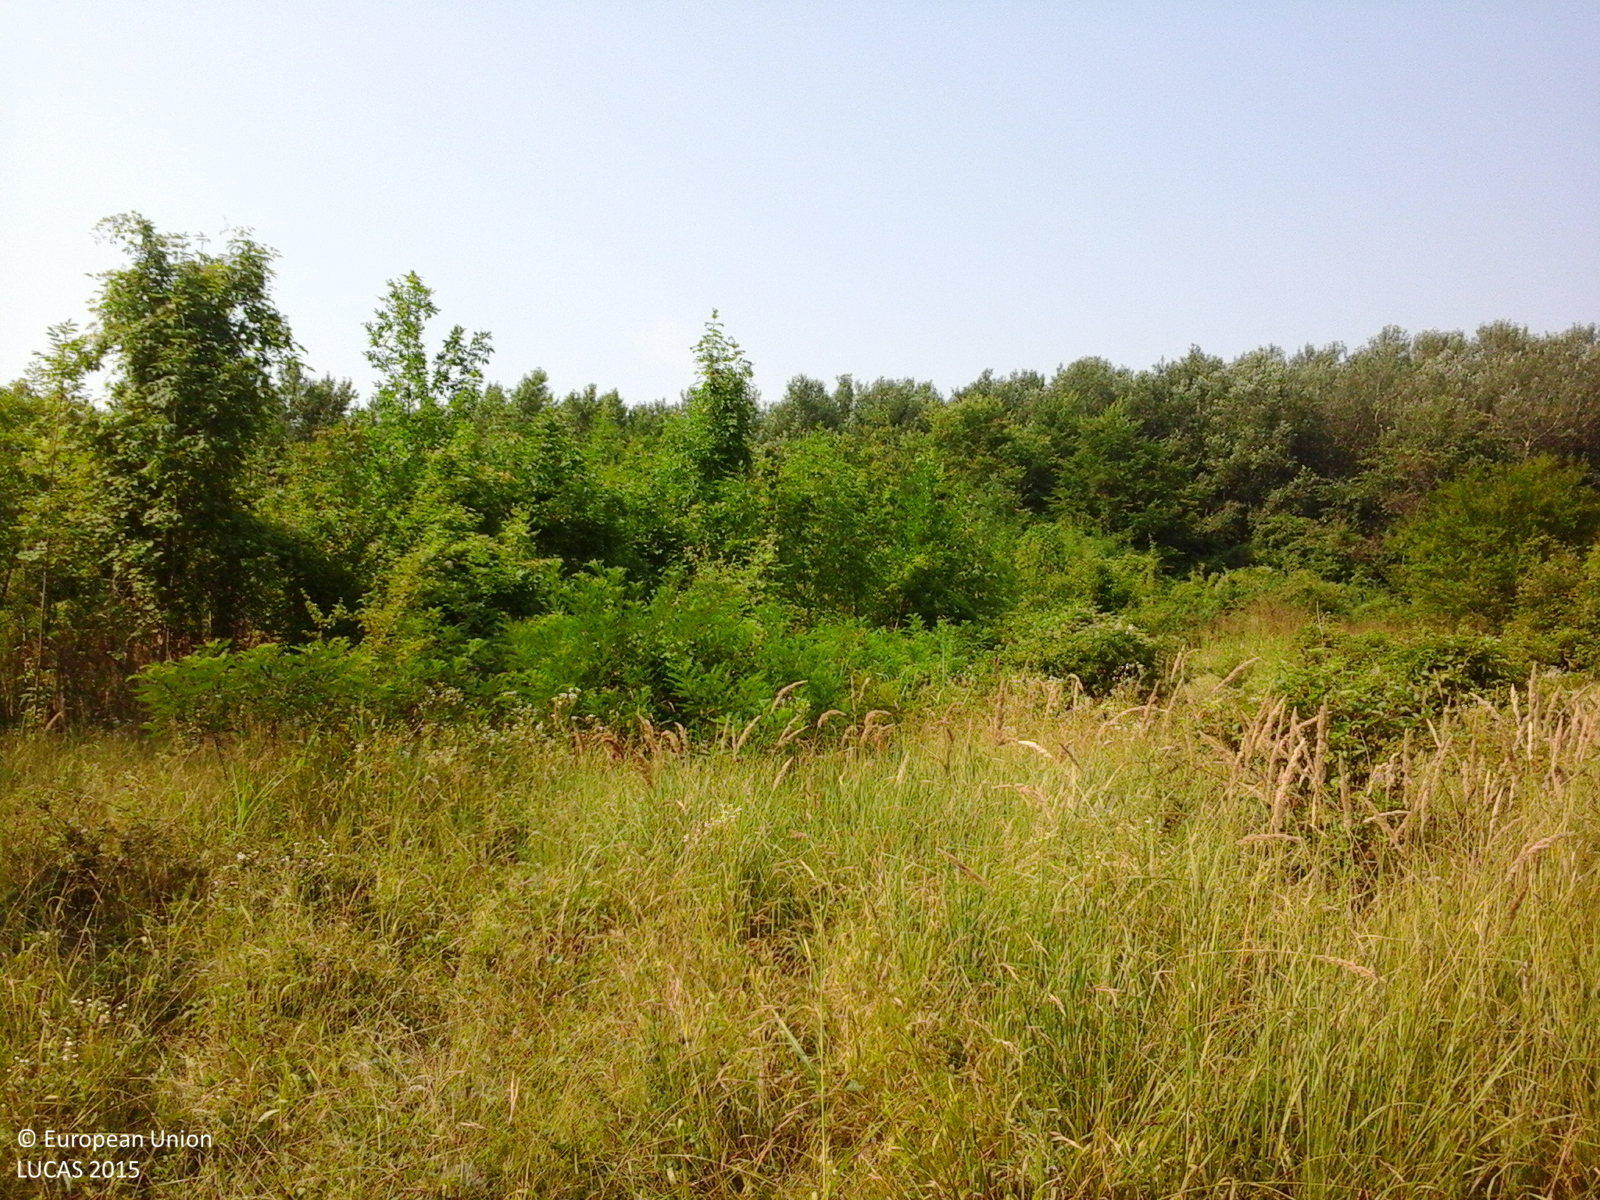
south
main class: Grassland
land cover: Grassland with sparse tree/shrub cover
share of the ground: > 75 %
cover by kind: herbaceous plants 85 %, shrubs 10 %, broadleaved forest trees 5 %
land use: Forestry
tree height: < 5 m
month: July
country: RO
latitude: 44.7913
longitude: 26.3316
